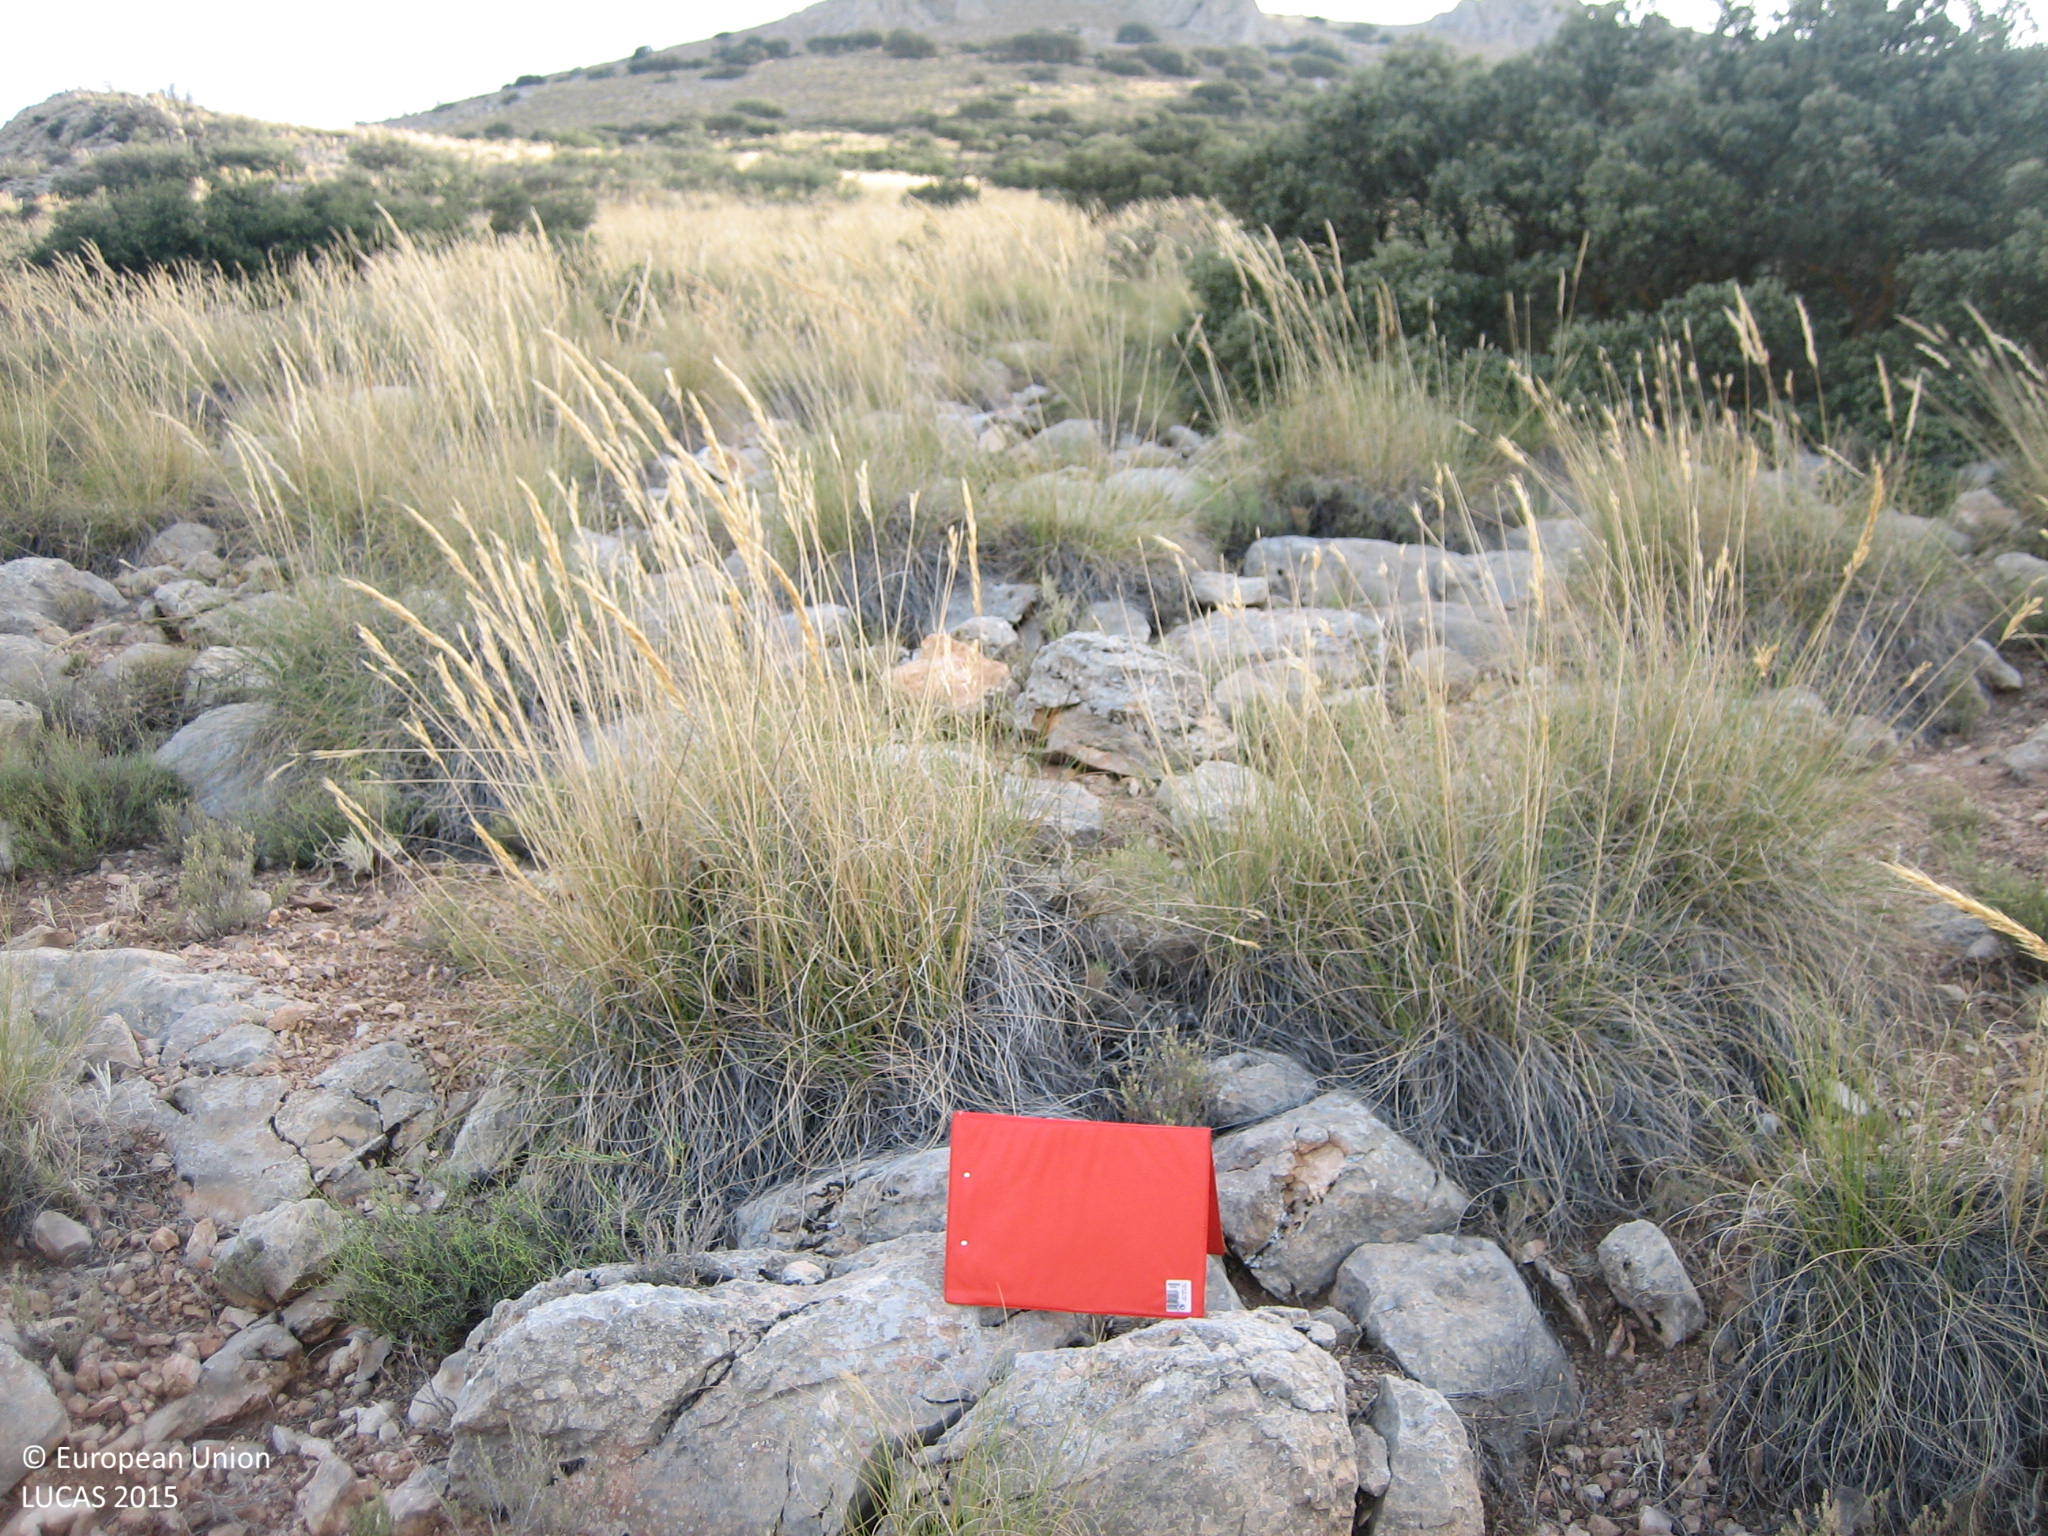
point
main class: Shrubland
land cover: Shrubland with sparse tree cover
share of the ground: 10 - 25 %
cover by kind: herbaceous plants 45 %, consolidated bare surface 30 %, shrubs 20 %, broadleaved forest trees 5 %
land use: Agriculture (excluding fallow land and kitchen gardens)
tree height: < 5 m
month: July
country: ES
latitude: 37.6176
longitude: -2.3461
